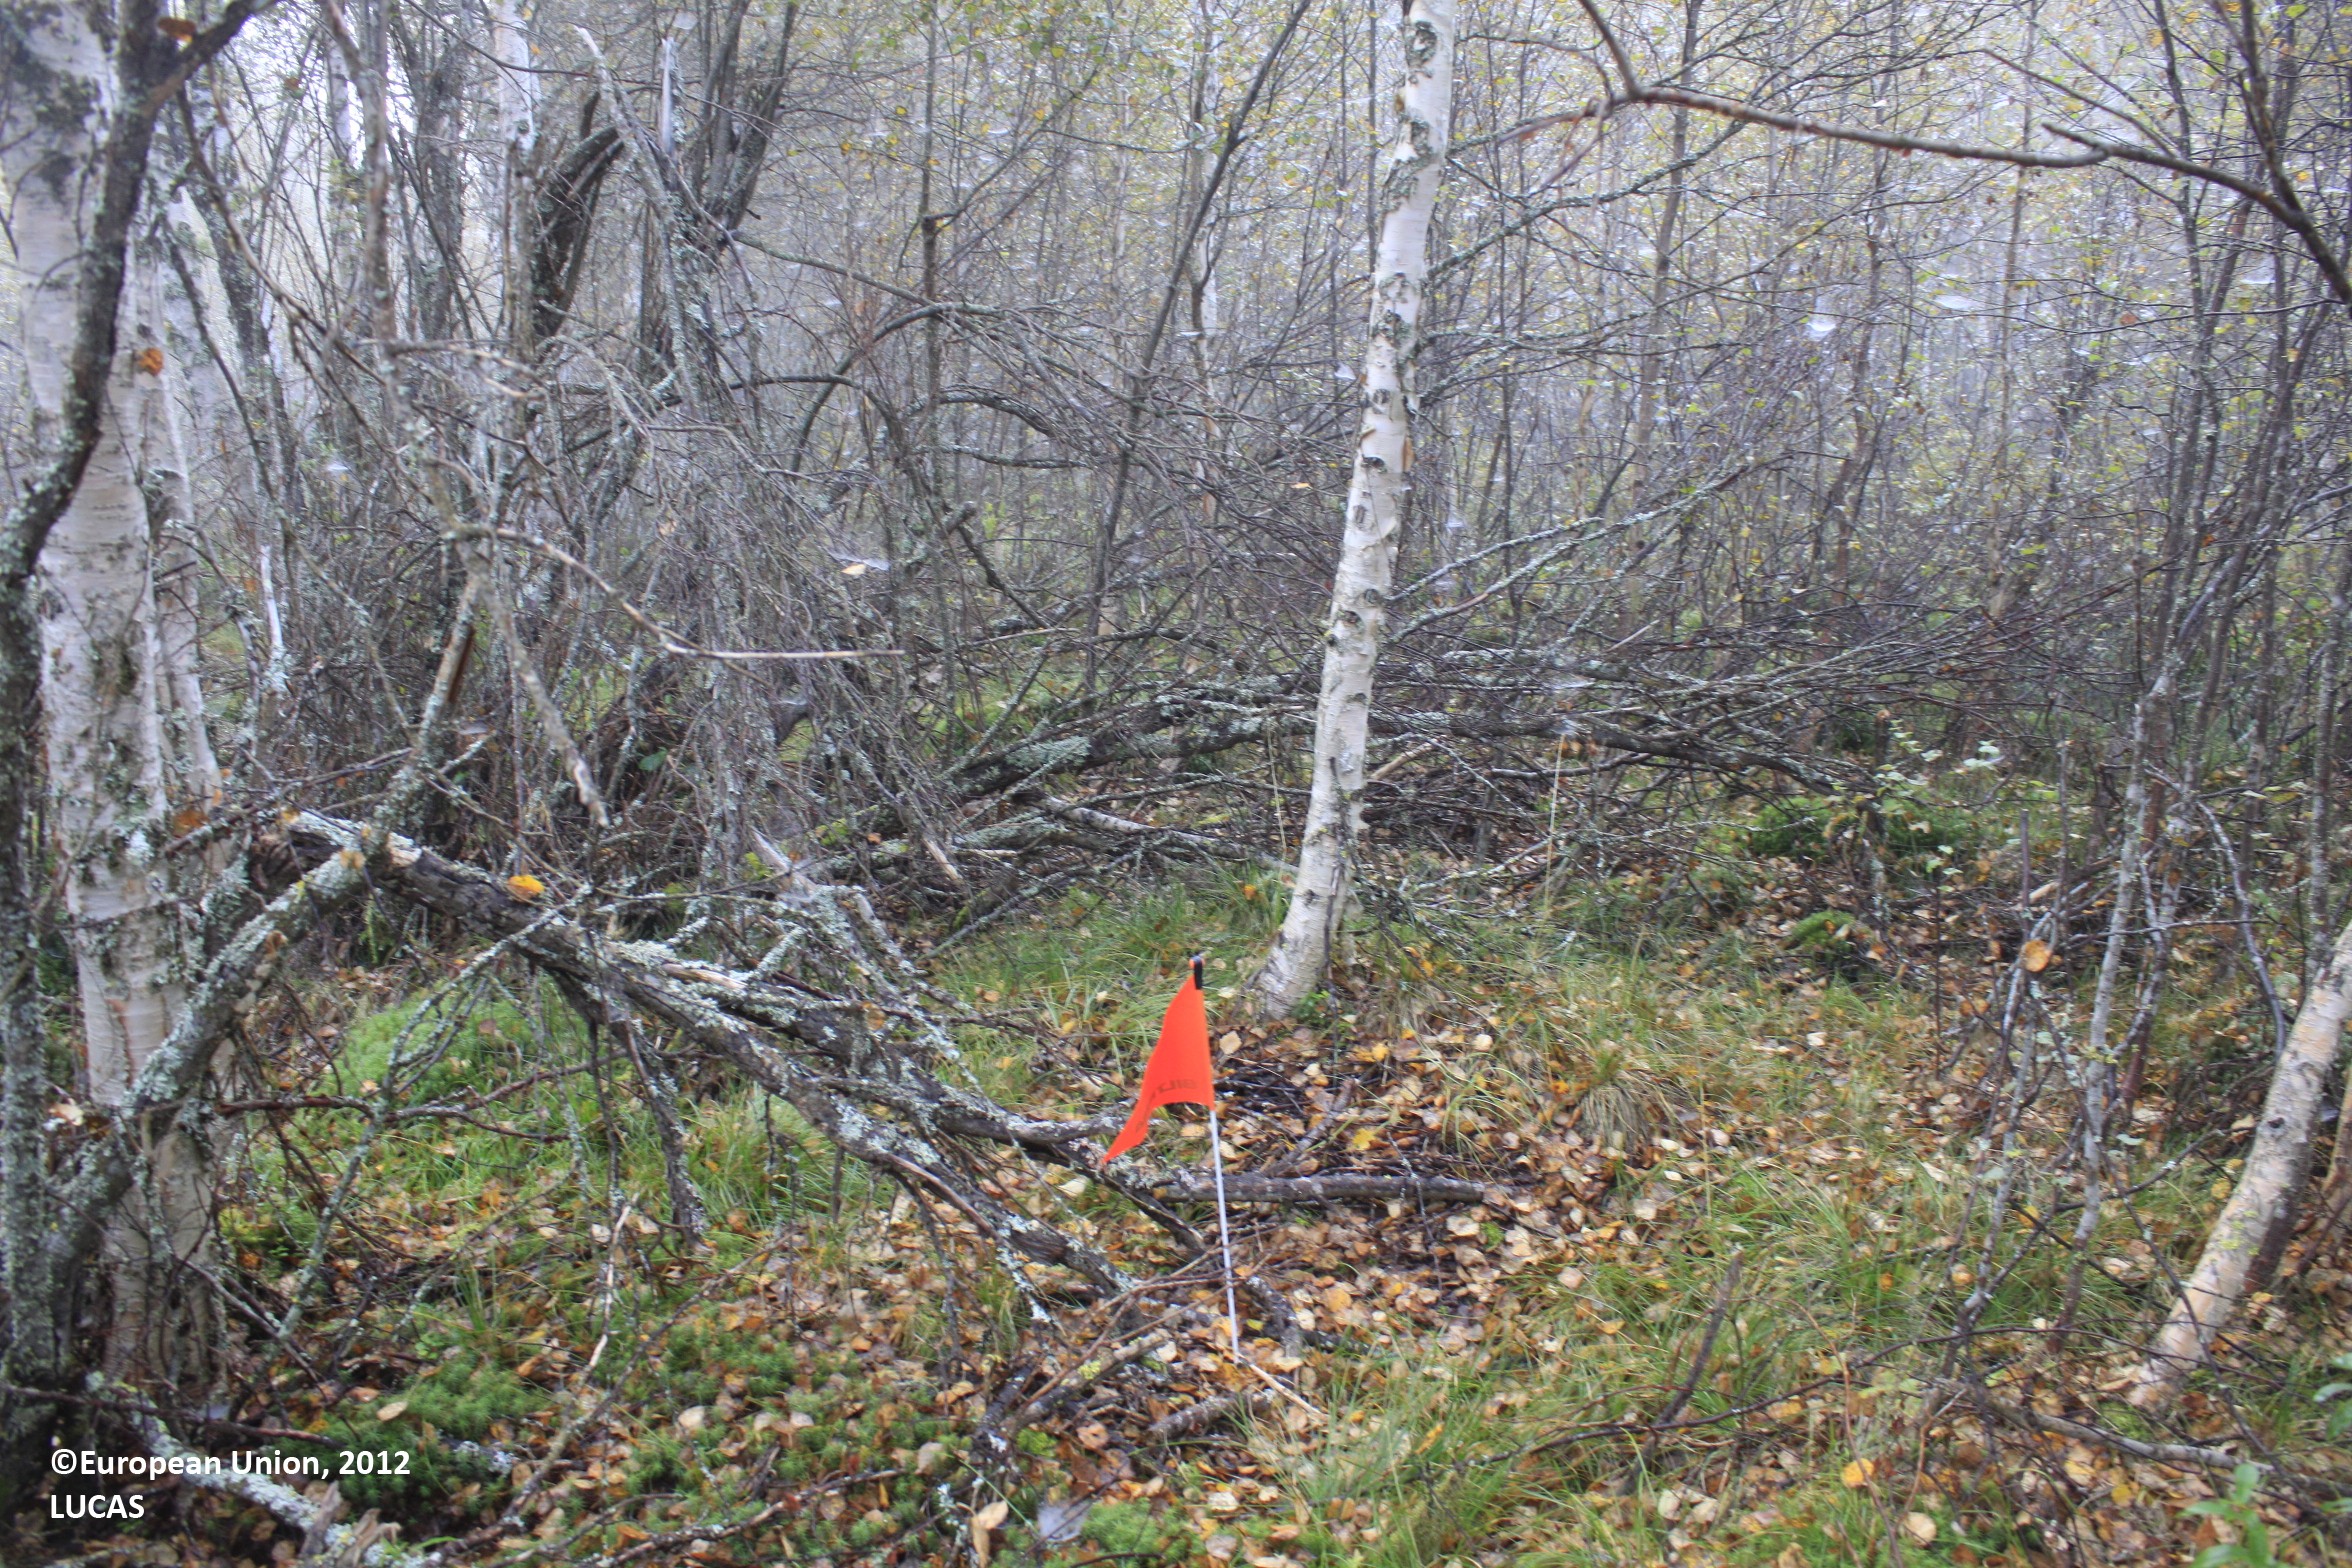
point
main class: Woodland
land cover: Broadleaved woodland
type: non-riverine alder, birch or aspen forest
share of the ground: 50 - 75 %
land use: Forestry
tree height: > 5 m
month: September
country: FI
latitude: 65.1924
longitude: 26.8837
